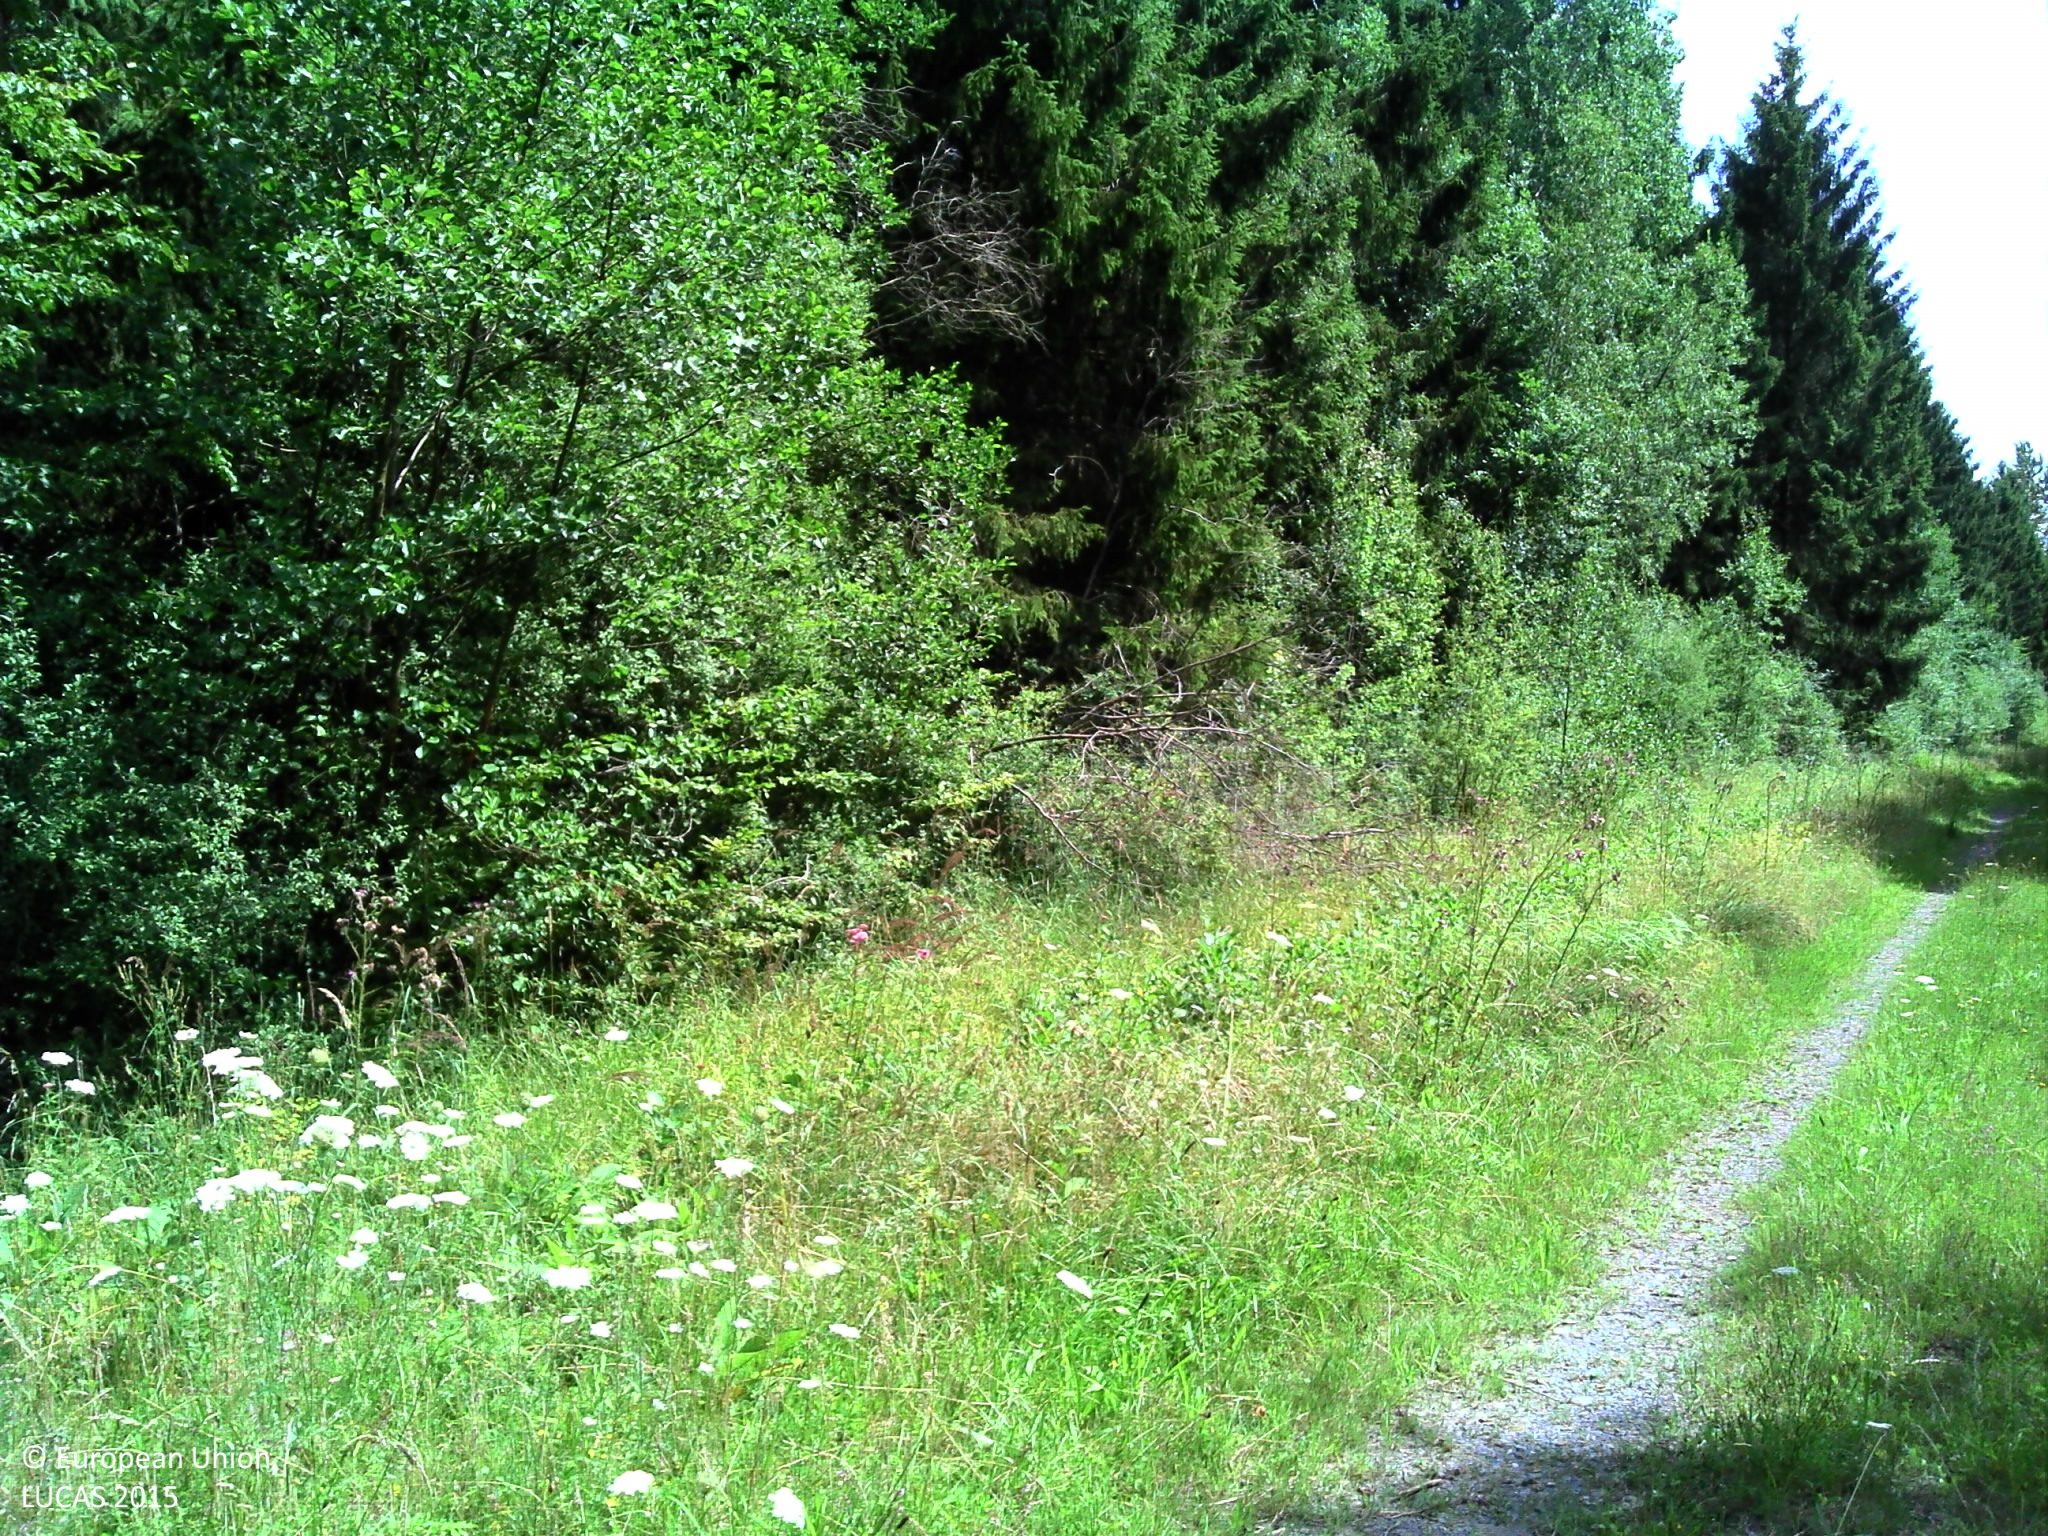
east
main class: Woodland
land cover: Broadleaved woodland
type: acidophilous oak and oak-birch forest
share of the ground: > 75 %
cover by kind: broadleaved forest trees 65 %, lichens and mosses 15 %, coniferous forest trees 10 %, herbaceous plants 5 %, consolidated bare surface 5 %
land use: Forestry
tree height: > 5 m
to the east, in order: Broadleaved woodland
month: August
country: FR
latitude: 50.0697
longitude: 4.1408
